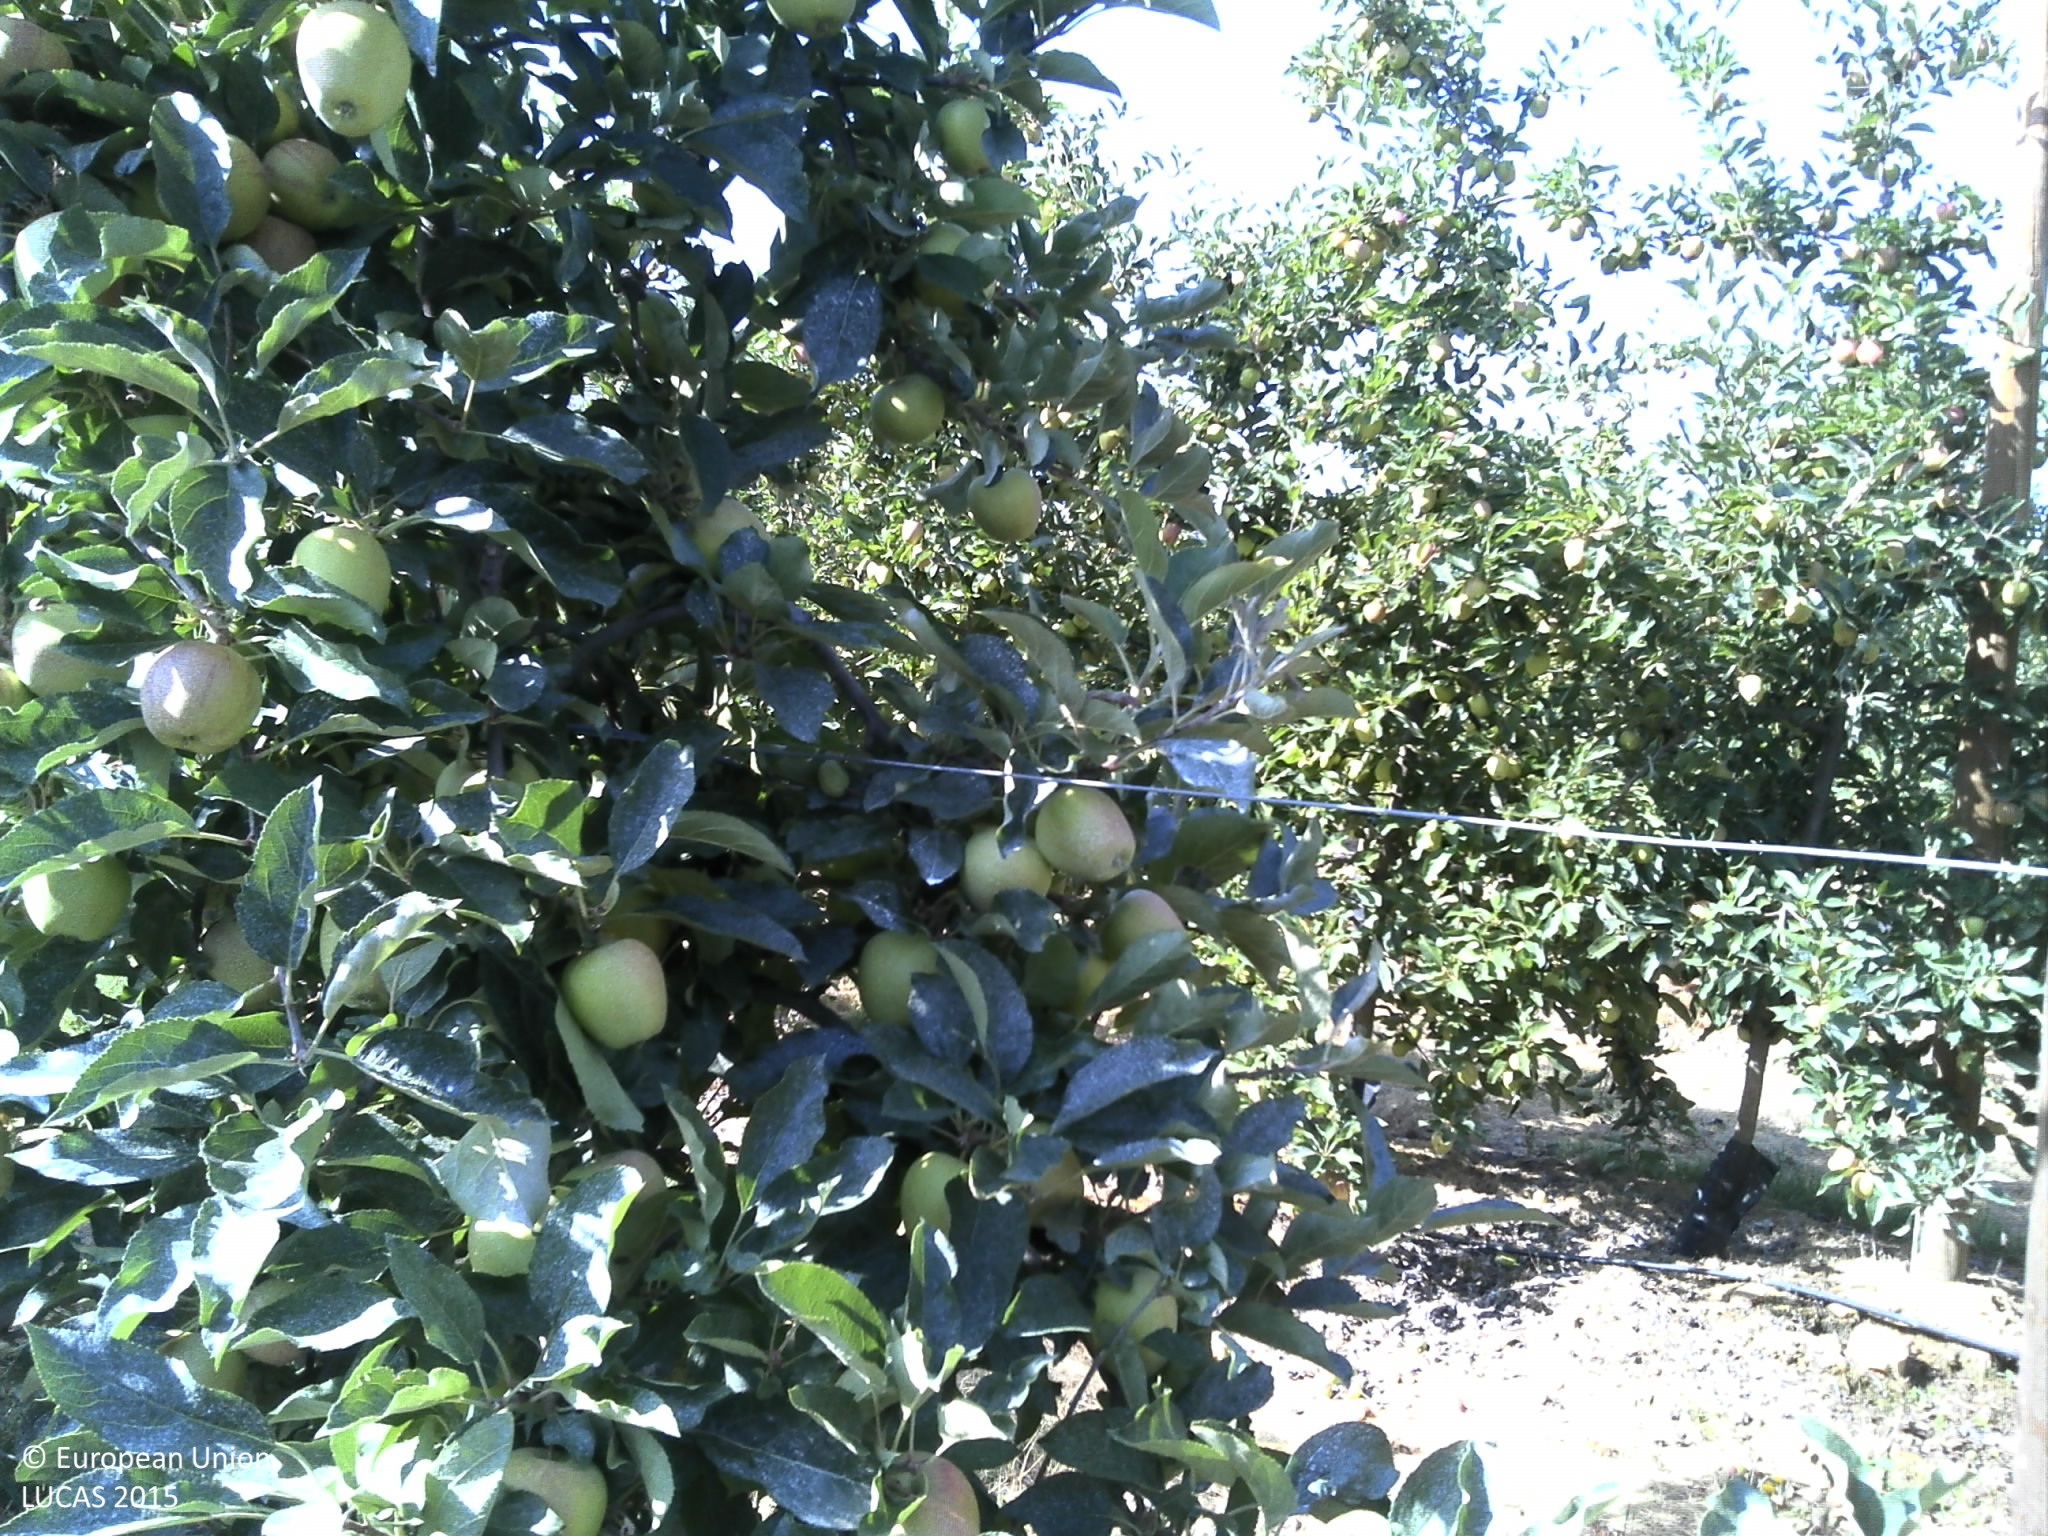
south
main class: Cropland
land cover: Apple fruit
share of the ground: 25 - 50 %
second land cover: Grassland without tree/shrub cover
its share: 10 - 25 %
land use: Agriculture (excluding fallow land and kitchen gardens)
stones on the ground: < 10 %
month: July
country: PT
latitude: 41.0509
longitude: -7.4538
